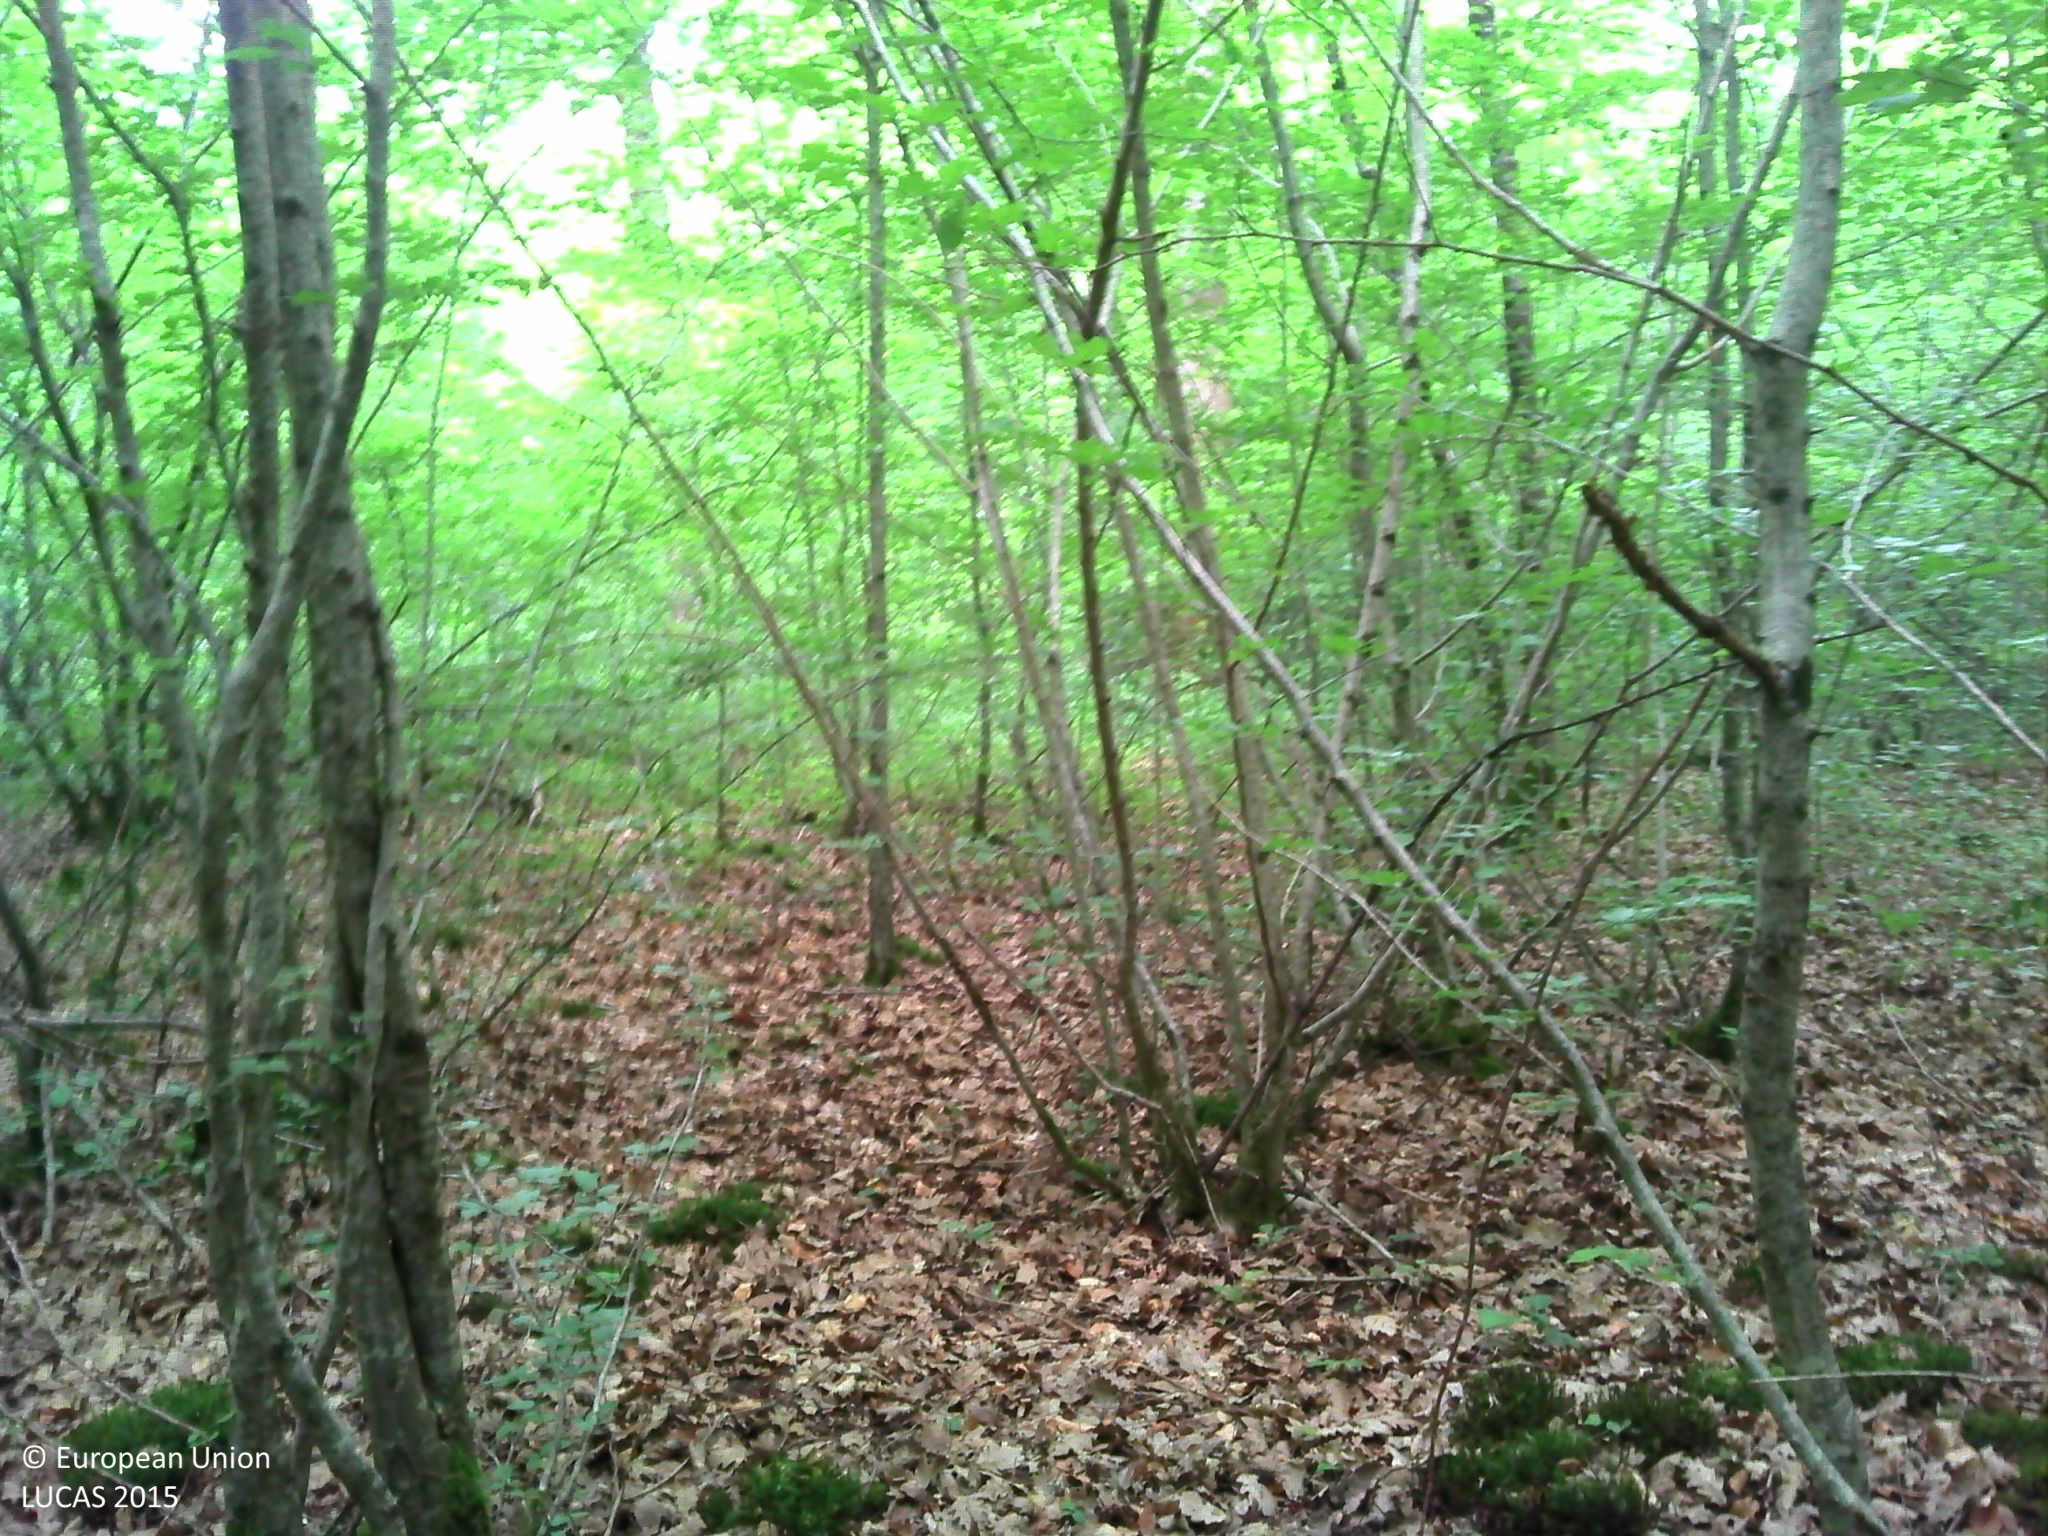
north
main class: Woodland
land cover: Broadleaved woodland
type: mesophytic deciduous forest
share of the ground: > 75 %
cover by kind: broadleaved forest trees 90 %, herbaceous plants 10 %
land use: Forestry
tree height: > 5 m
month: June
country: FR
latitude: 48.5020
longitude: 4.8958
